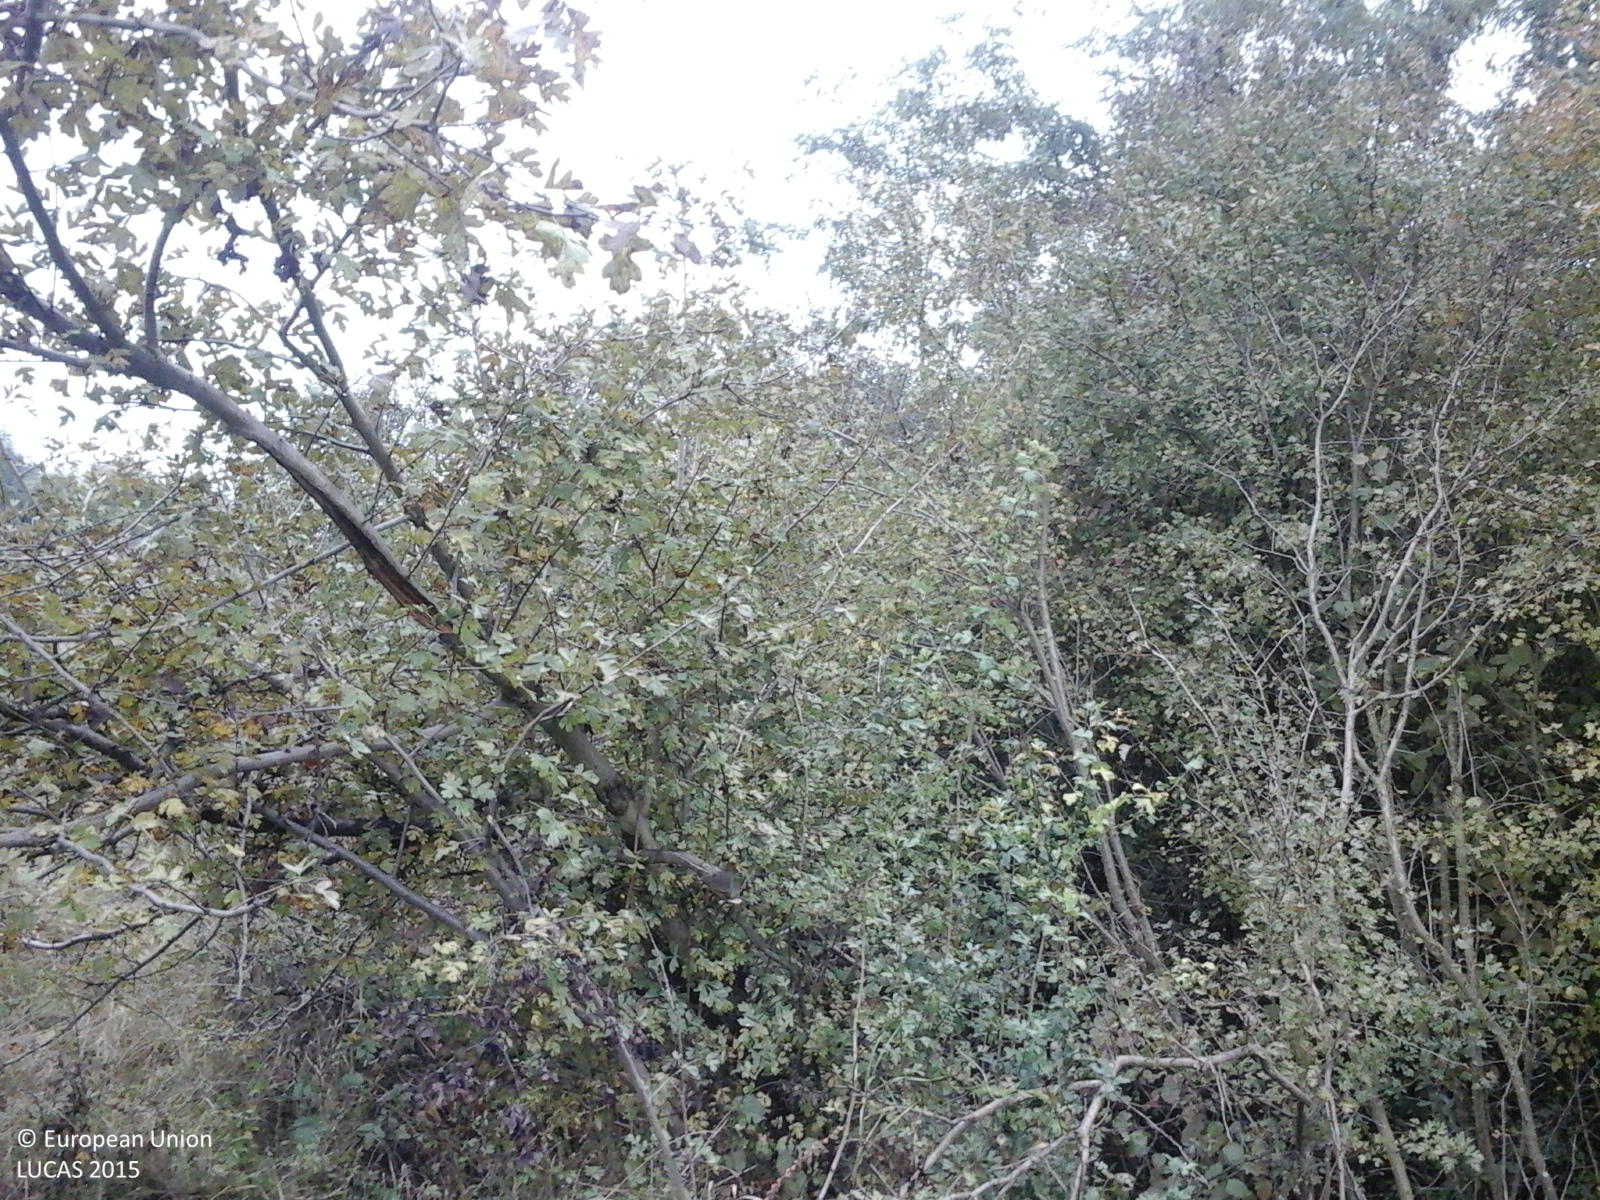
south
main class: Grassland
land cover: Grassland with sparse tree/shrub cover
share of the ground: > 75 %
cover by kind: herbaceous plants 95 %, broadleaved forest trees 5 %
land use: Agriculture (excluding fallow land and kitchen gardens)
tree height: < 5 m
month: October
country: RO
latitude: 45.7587
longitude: 24.1003
